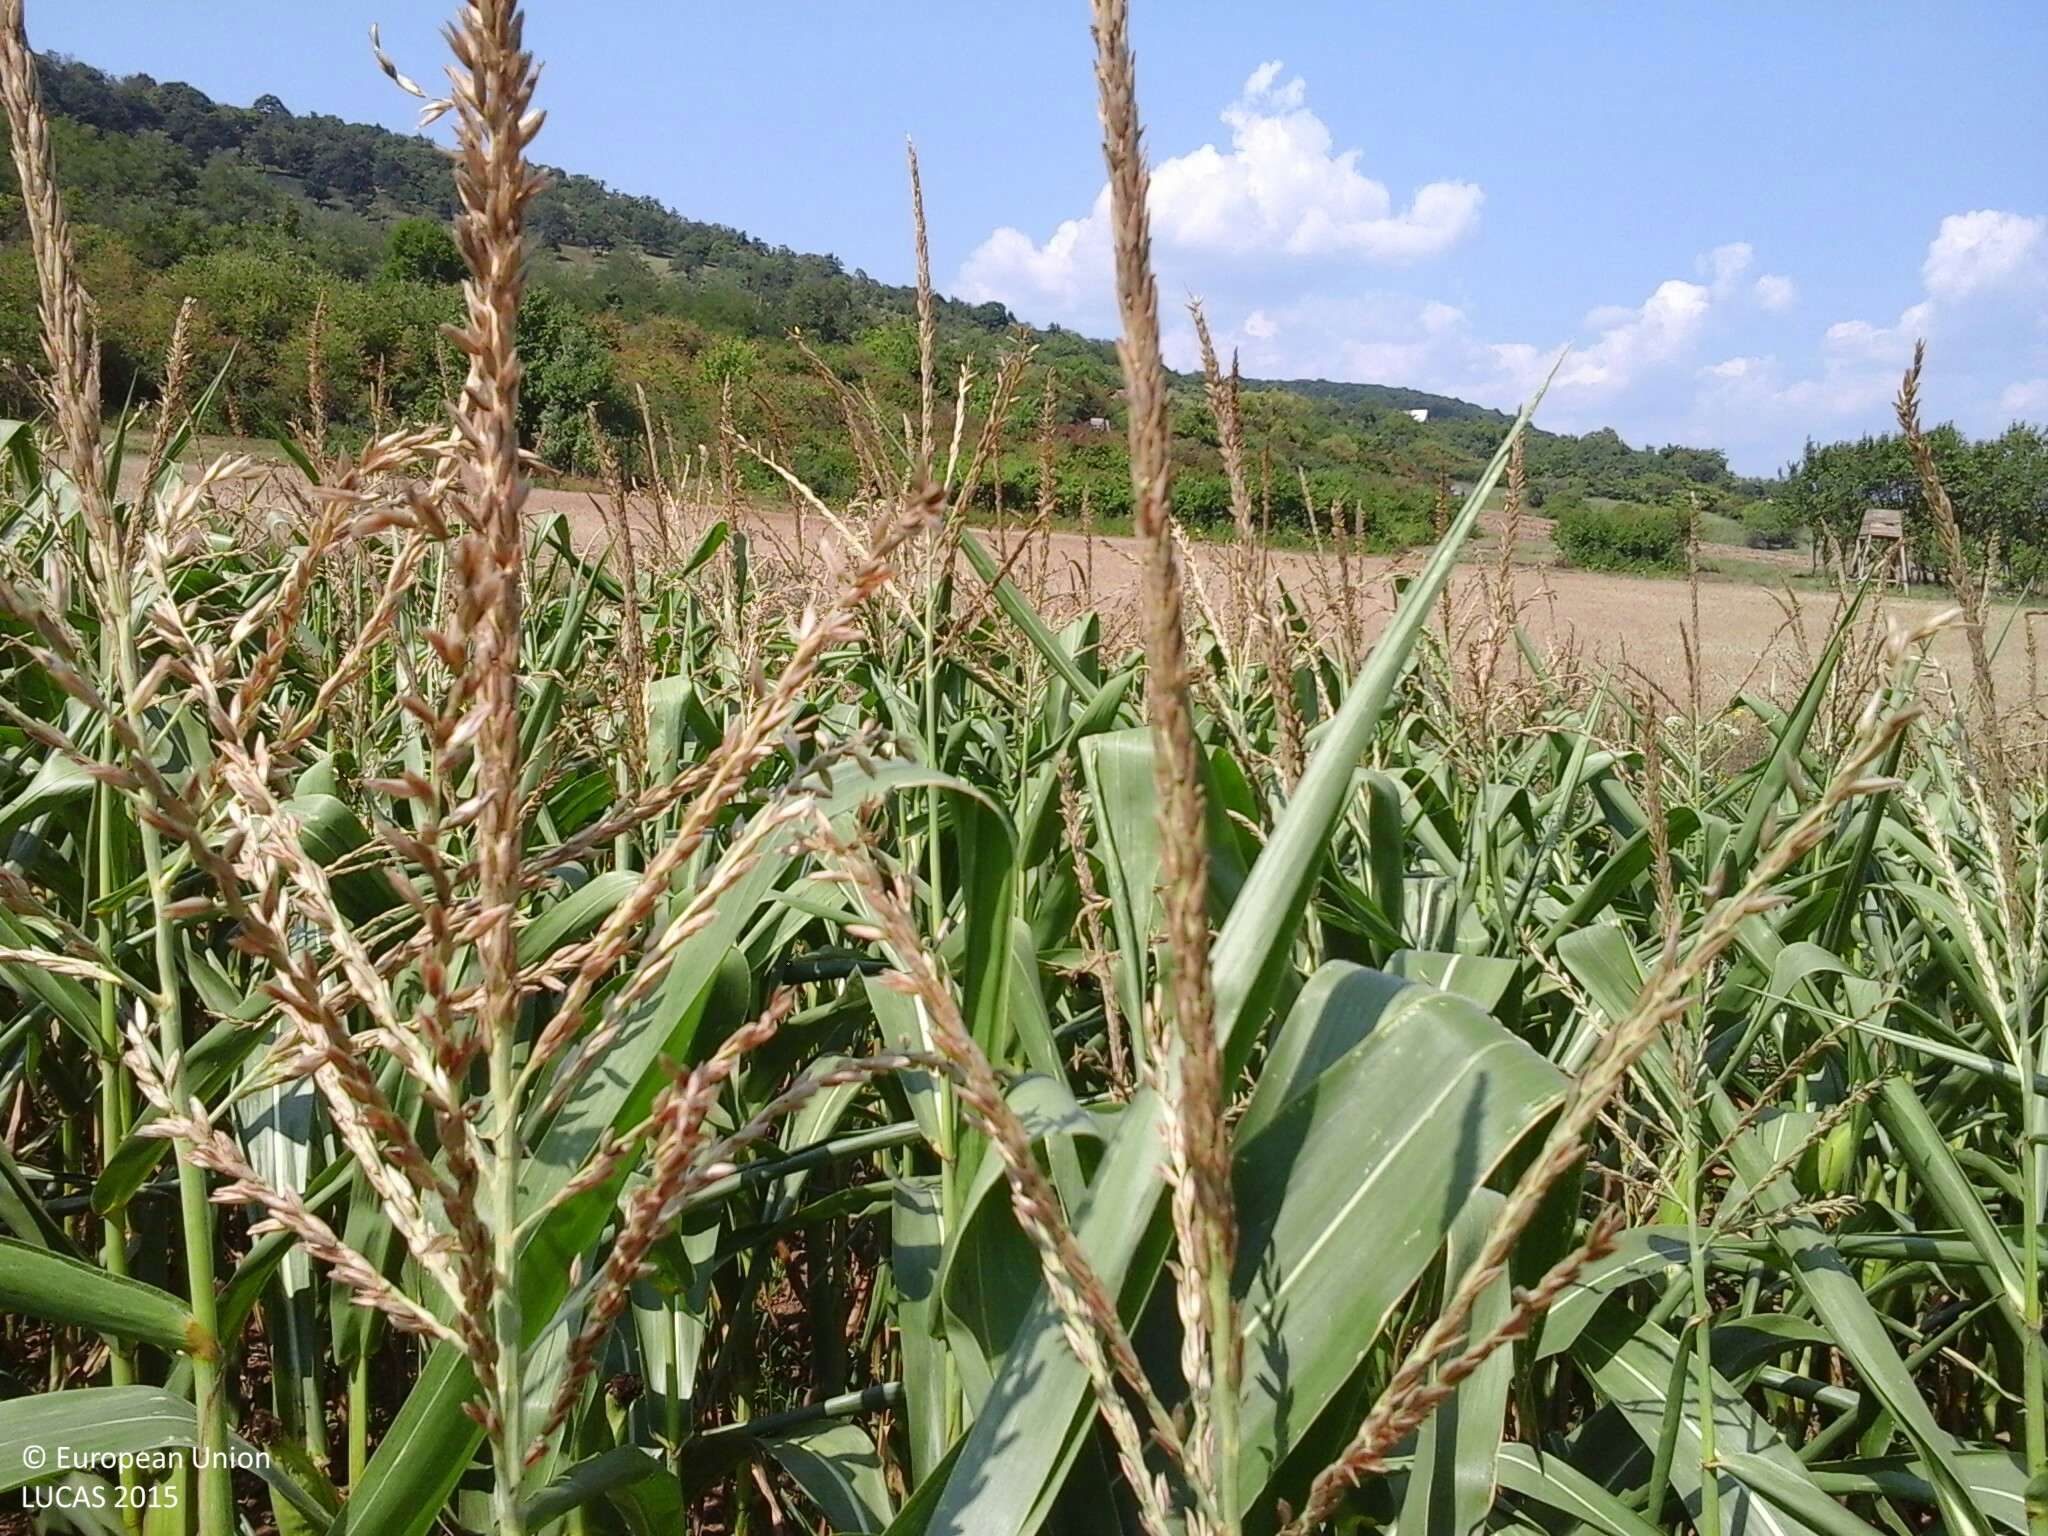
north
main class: Cropland
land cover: Maize
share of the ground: > 75 %
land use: Agriculture (excluding fallow land and kitchen gardens)
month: August
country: HU
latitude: 48.4272
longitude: 20.6997
